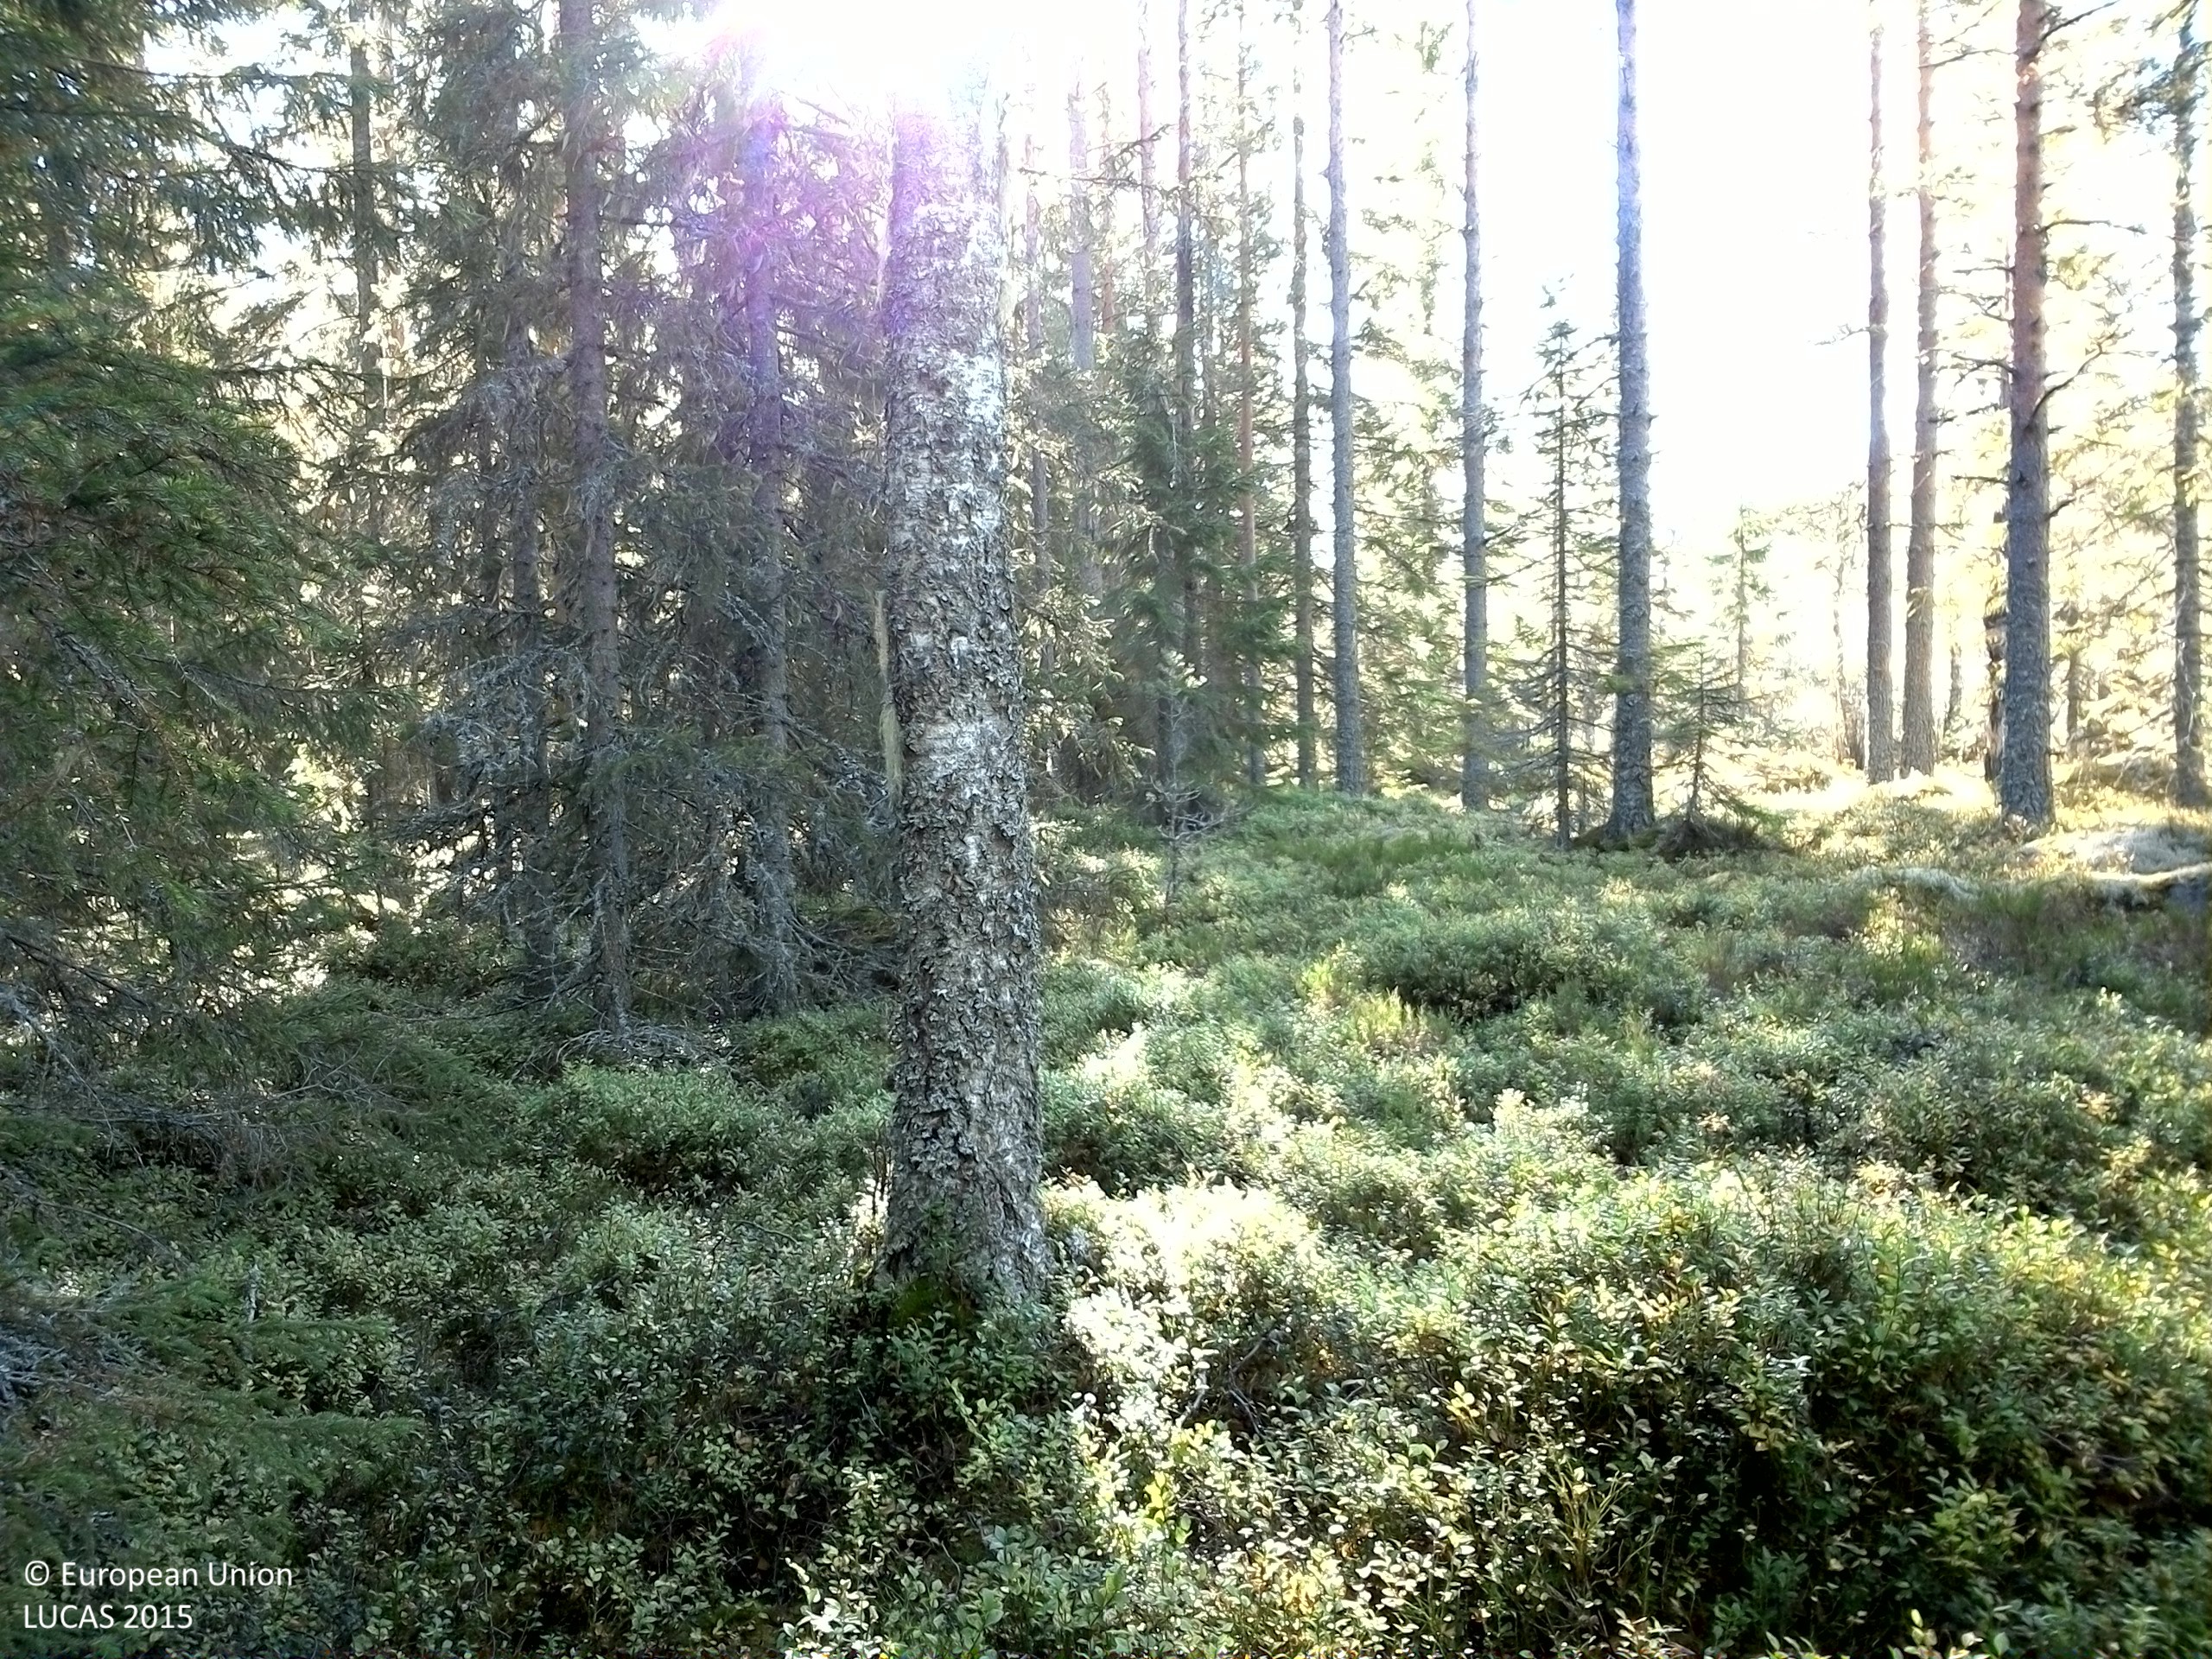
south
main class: Woodland
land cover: Spruce dominated mixed woodland
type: boreal forest
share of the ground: 50 - 75 %
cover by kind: coniferous forest trees 50 %, shrubs 25 %, broadleaved forest trees 20 %, lichens and mosses 5 %
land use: Forestry
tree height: > 5 m
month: October
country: SE
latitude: 61.2366
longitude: 15.2945
